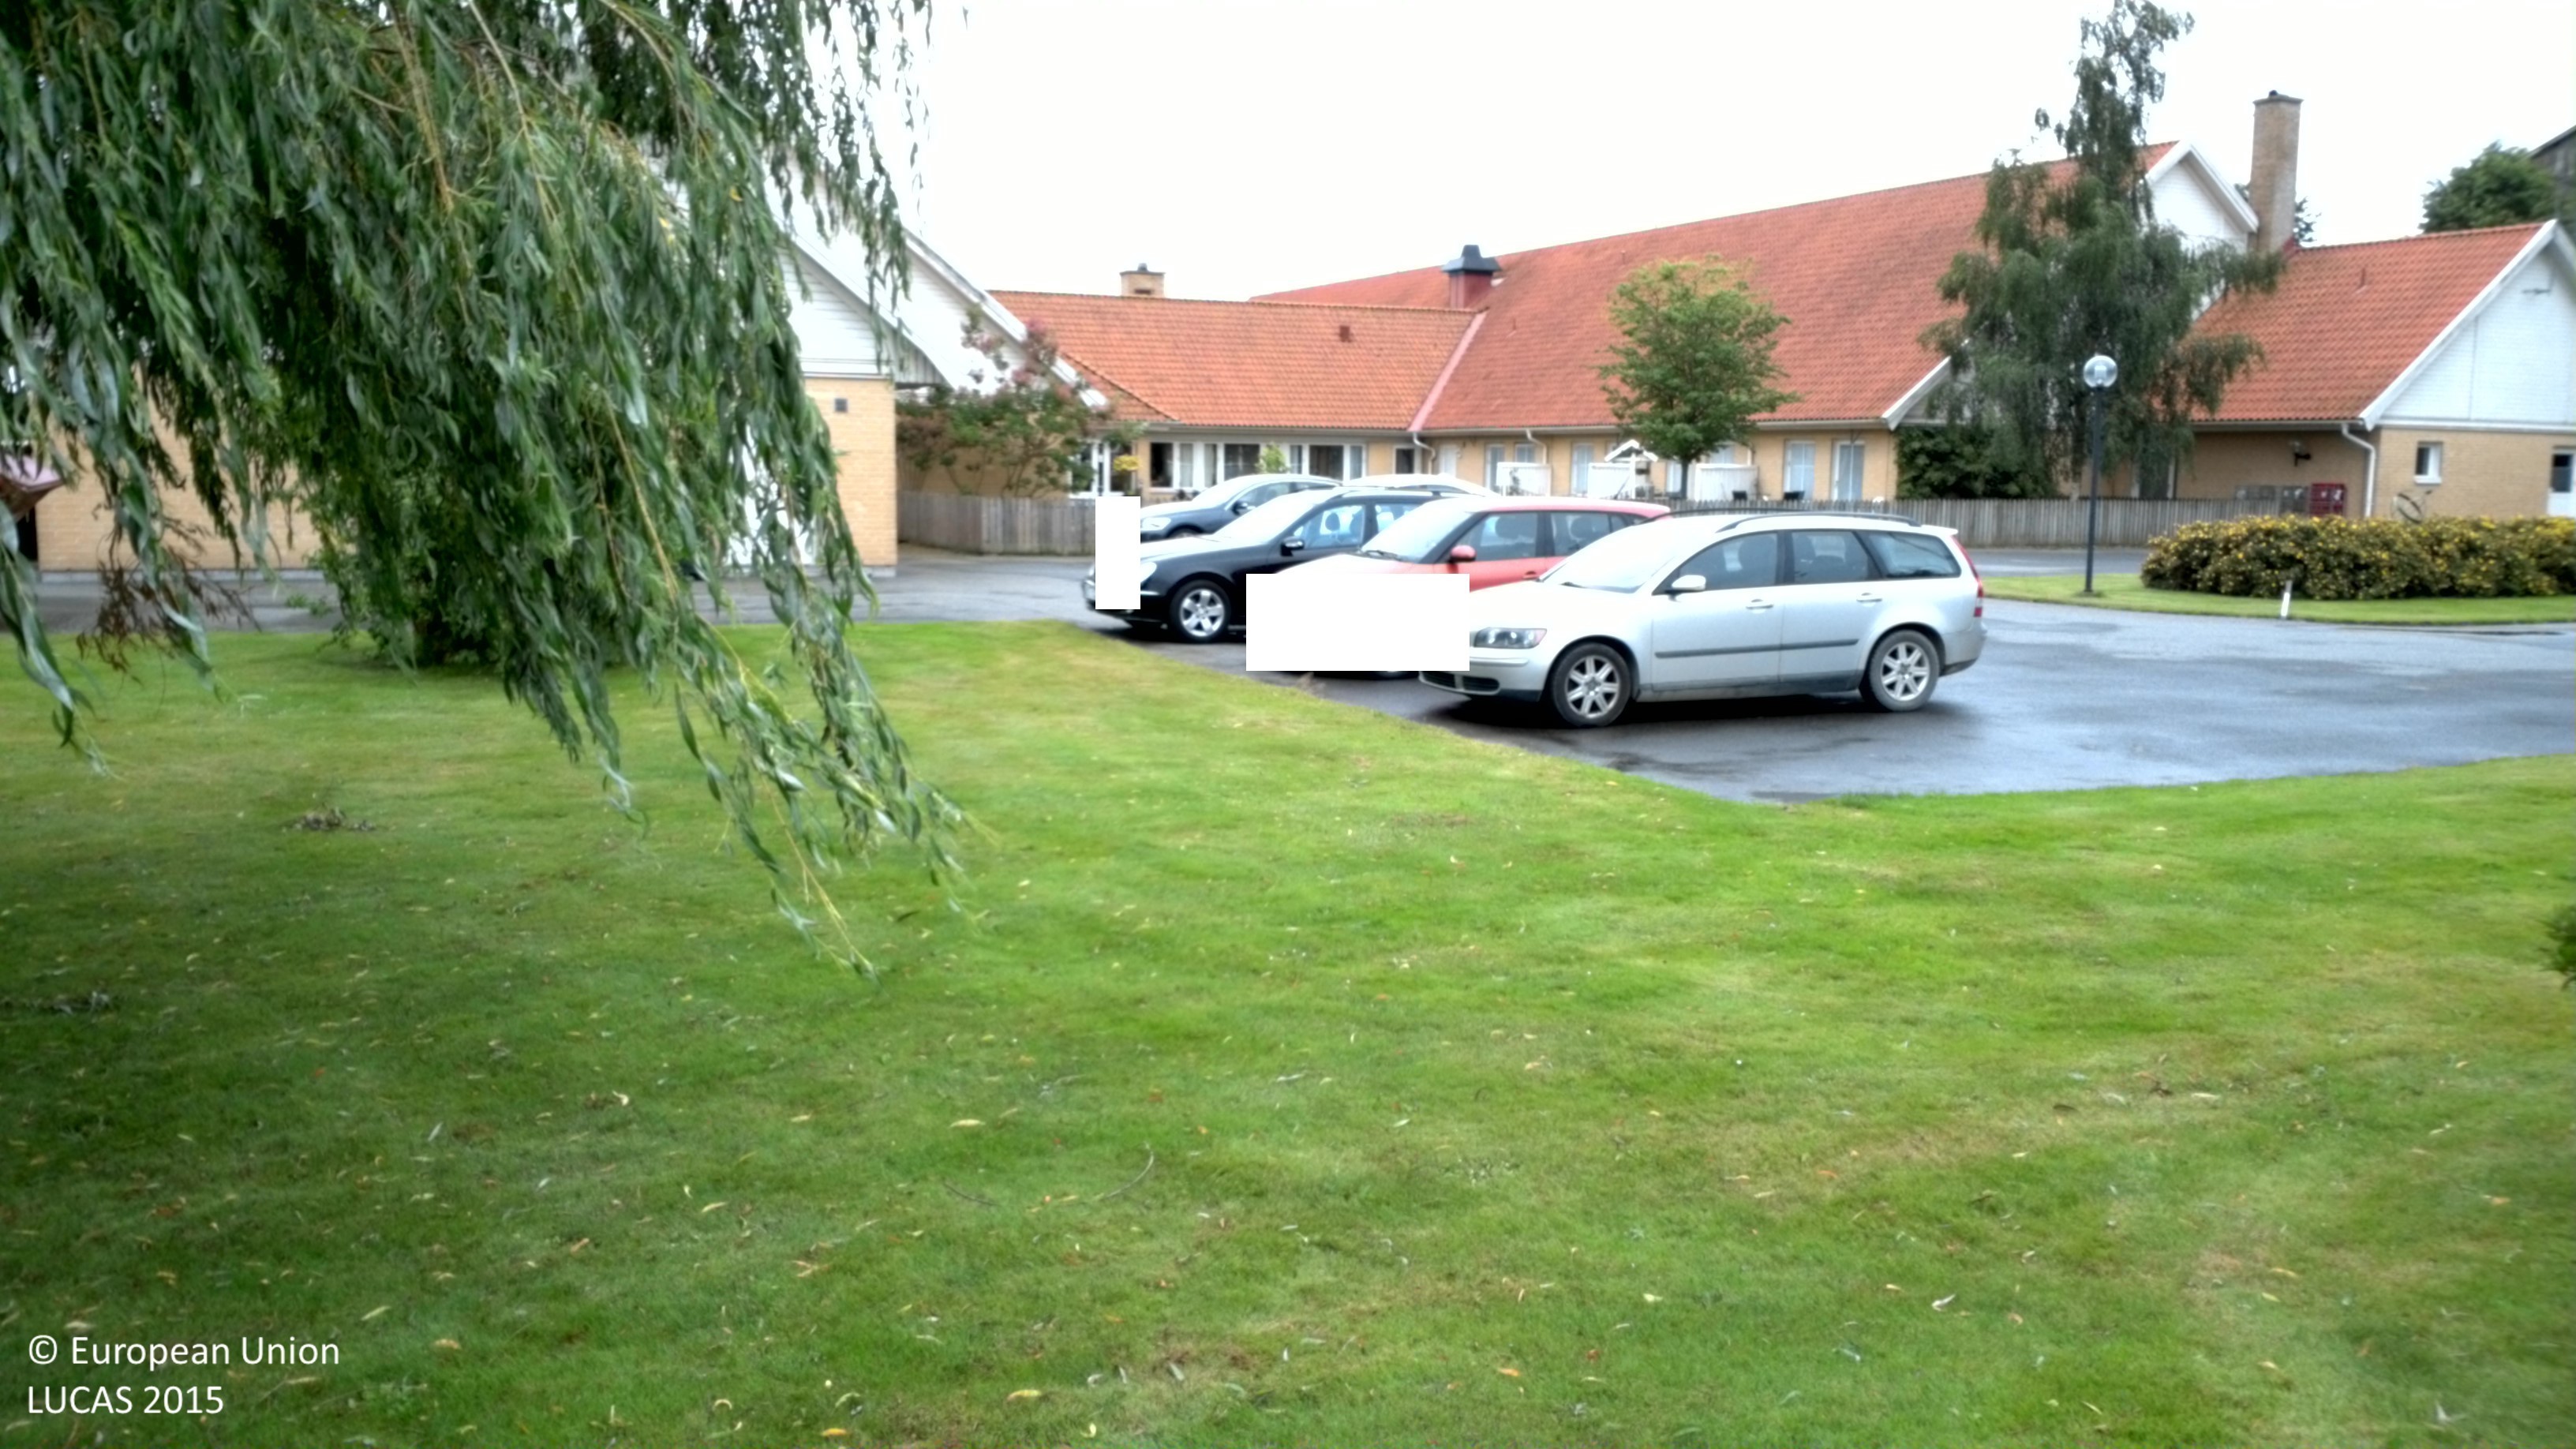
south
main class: Grassland
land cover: Grassland with sparse tree/shrub cover
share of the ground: > 75 %
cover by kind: herbaceous plants 95 %, broadleaved forest trees 5 %
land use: Community services
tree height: < 5 m
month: July
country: SE
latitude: 55.8891
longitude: 14.0752
